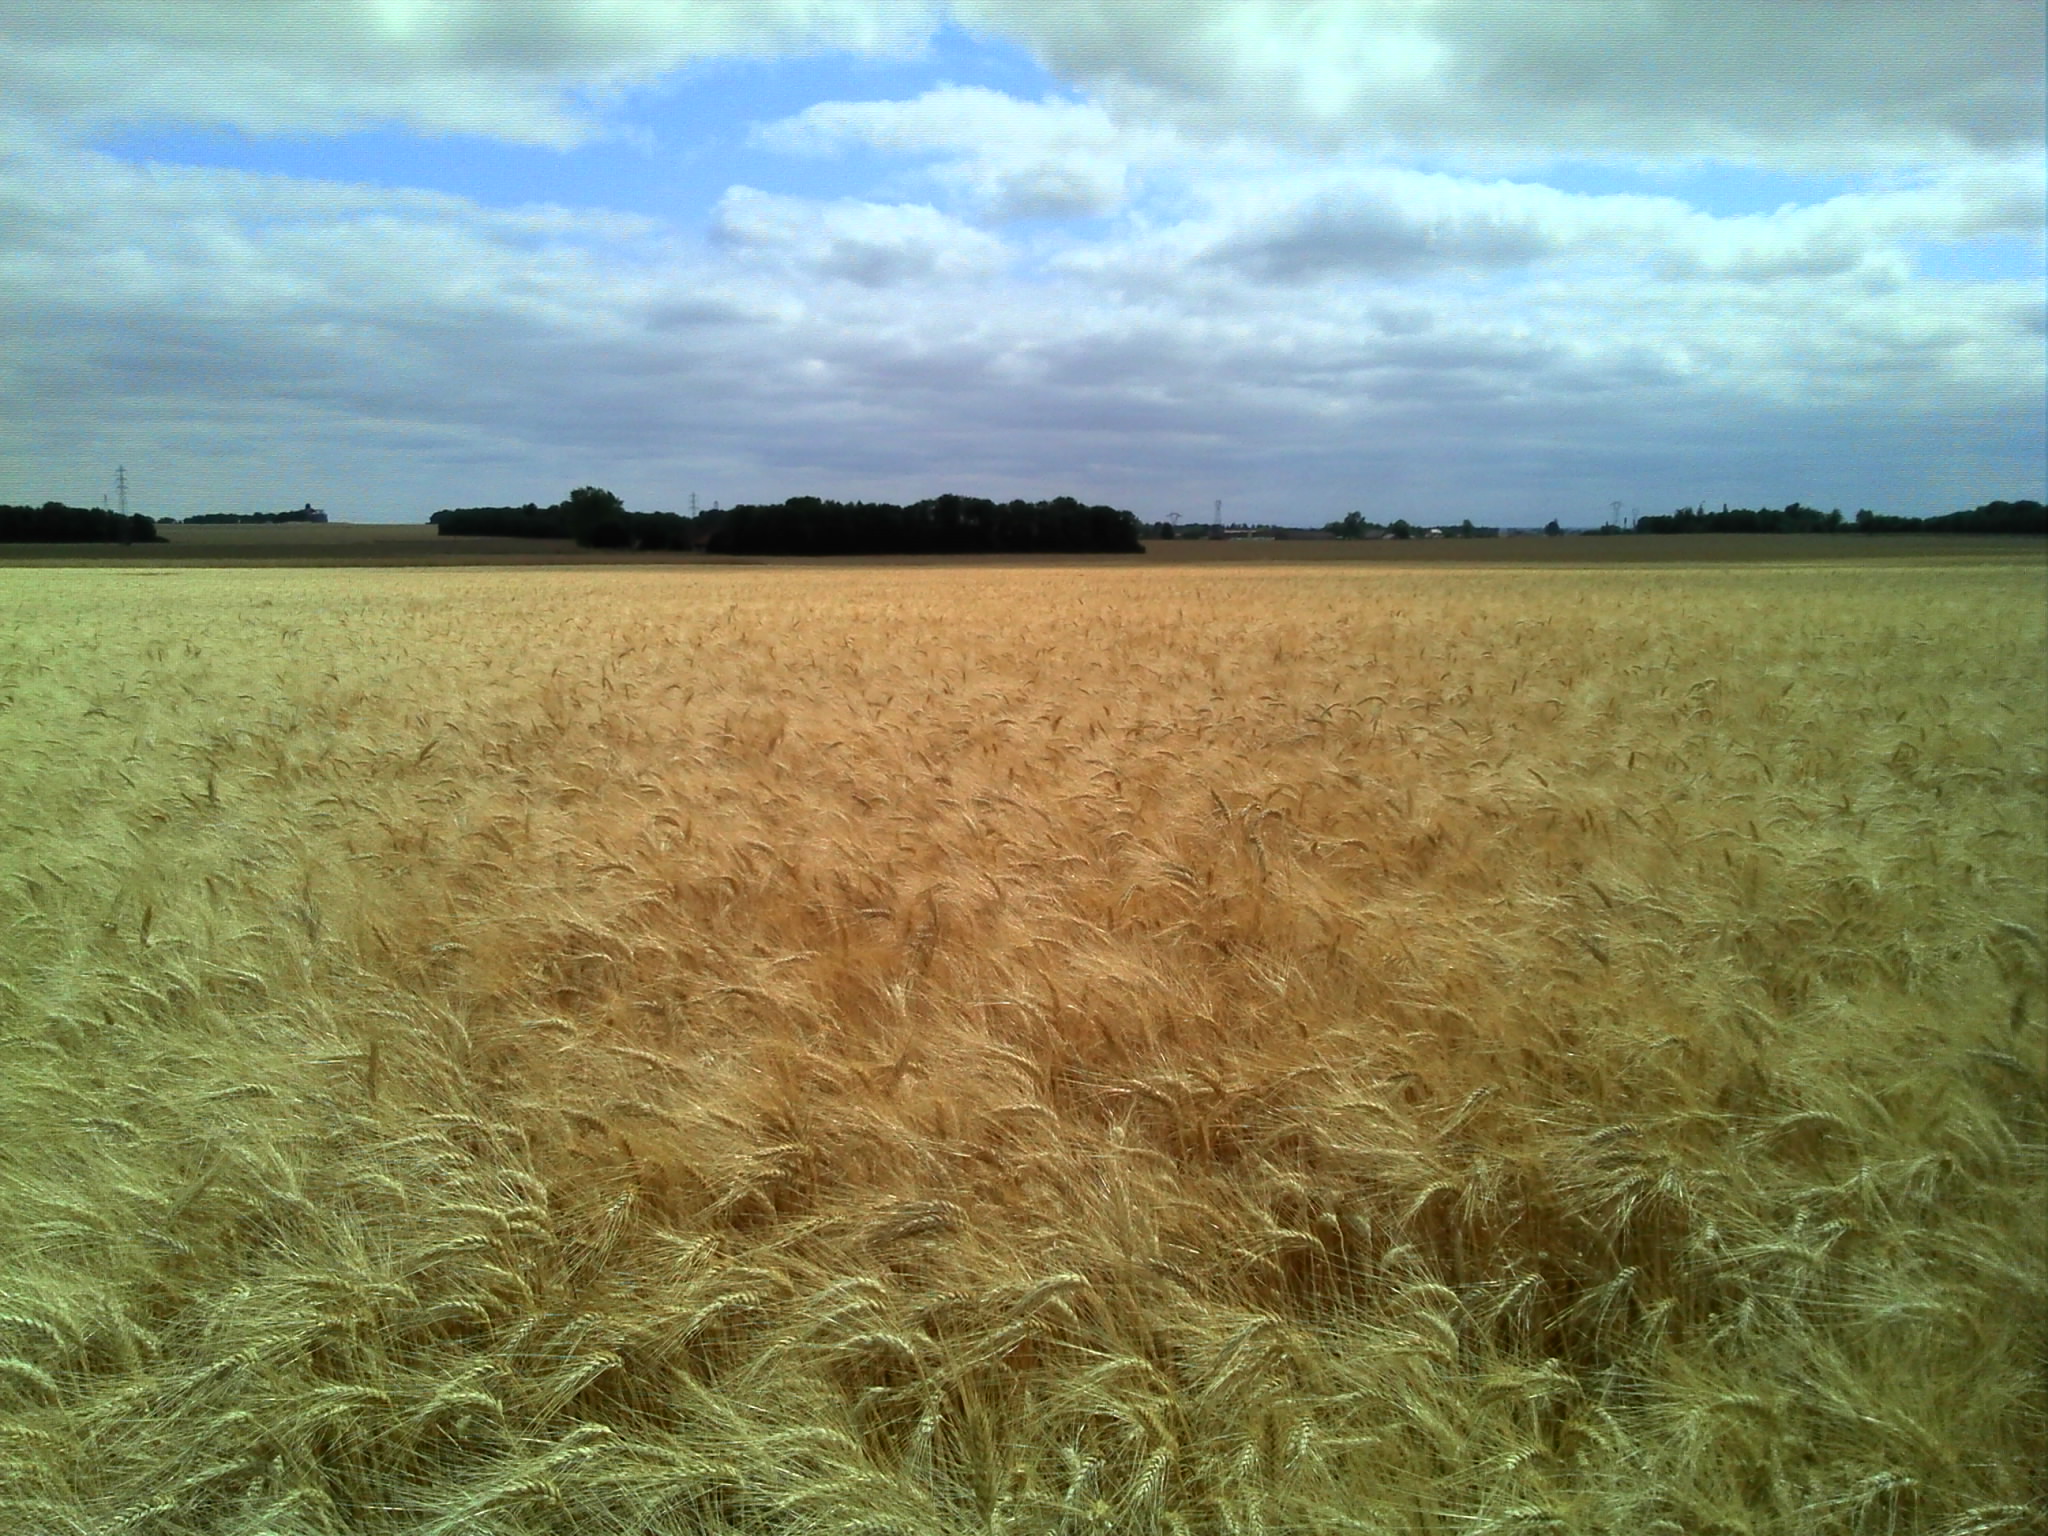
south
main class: Cropland
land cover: Barley
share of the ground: > 75 %
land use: Agriculture (excluding fallow land and kitchen gardens)
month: July
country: FR
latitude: 48.7923
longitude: 0.9535
